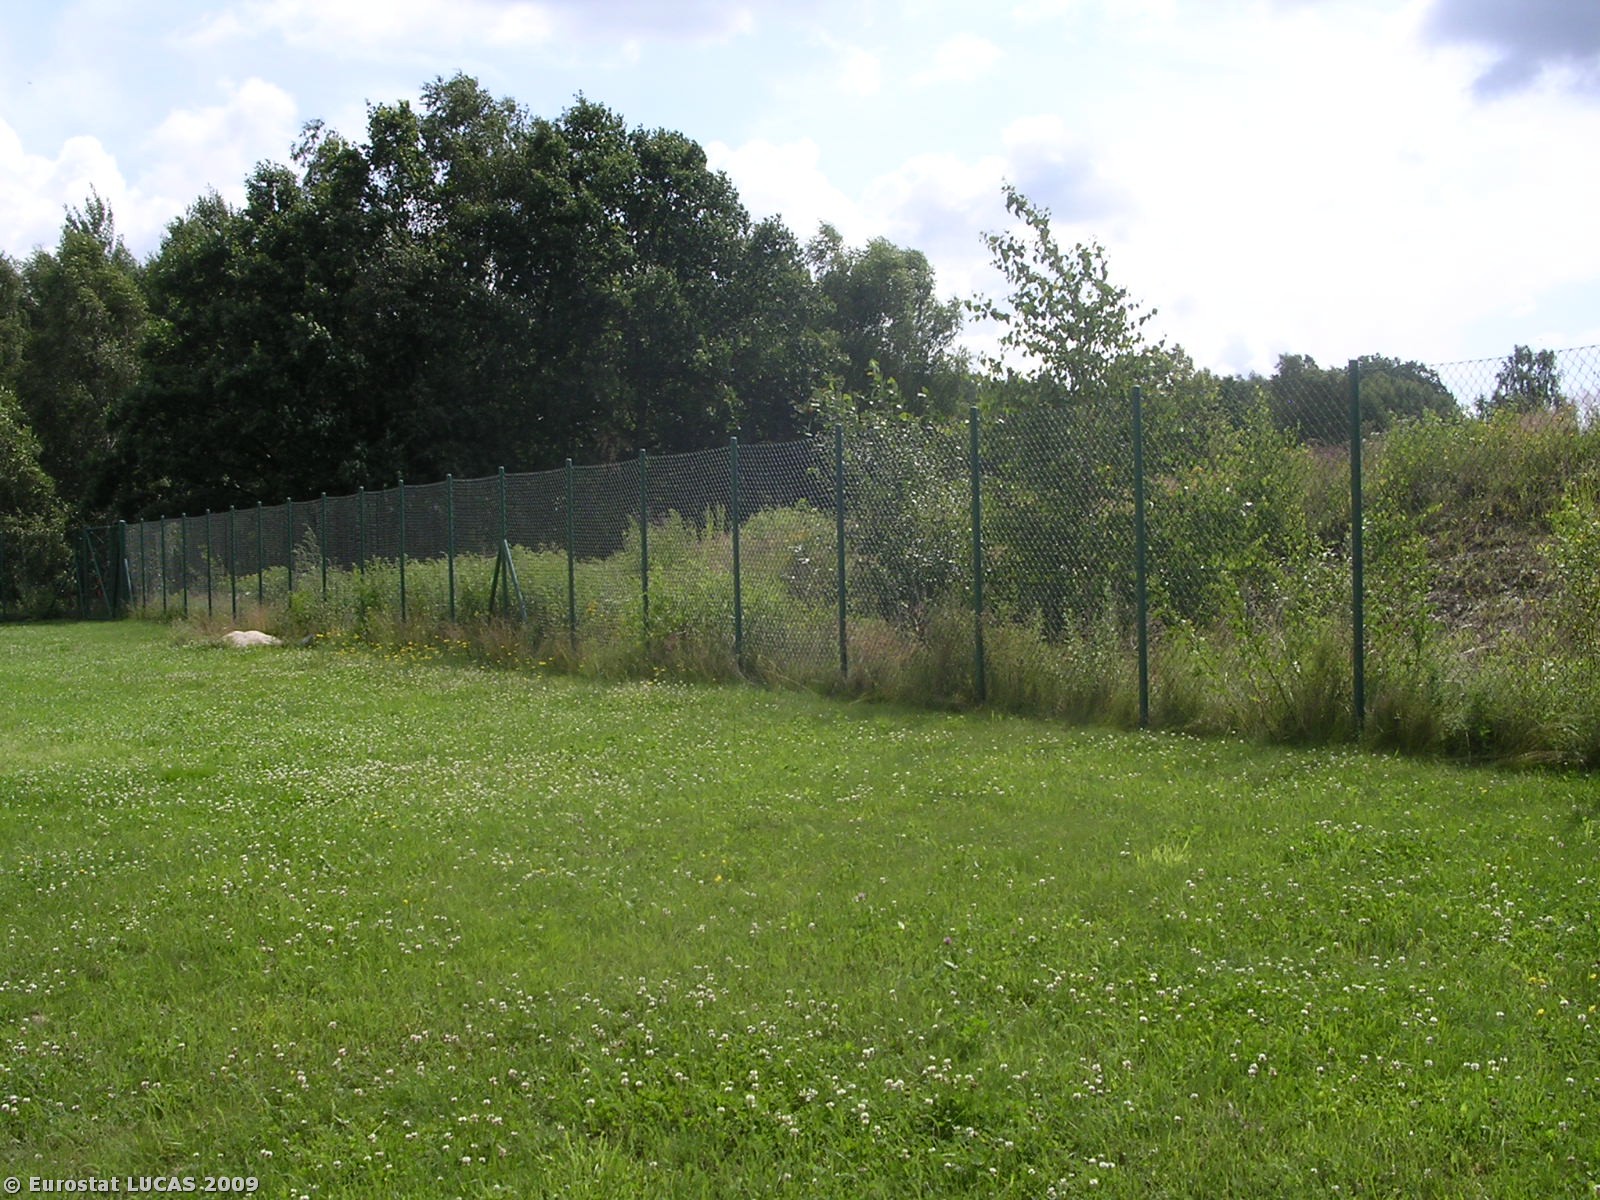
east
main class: Grassland
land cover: Grassland without tree/shrub cover
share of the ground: > 75 %
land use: Community services
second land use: Sport
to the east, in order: Grassland without tree/shrub cover; Fences; Spontaneously vegetated surfaces; Grassland without tree/shrub cover; Broadleaved woodland; Tracks; Broadleaved woodland; Tracks; Broadleaved woodland; Grassland with sparse tree/shrub cover; Tracks; Mixed woodland; Coniferous woodland; Mixed woodland; Bare land; Mixed woodland
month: July
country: CZ
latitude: 50.6700
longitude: 14.5438
